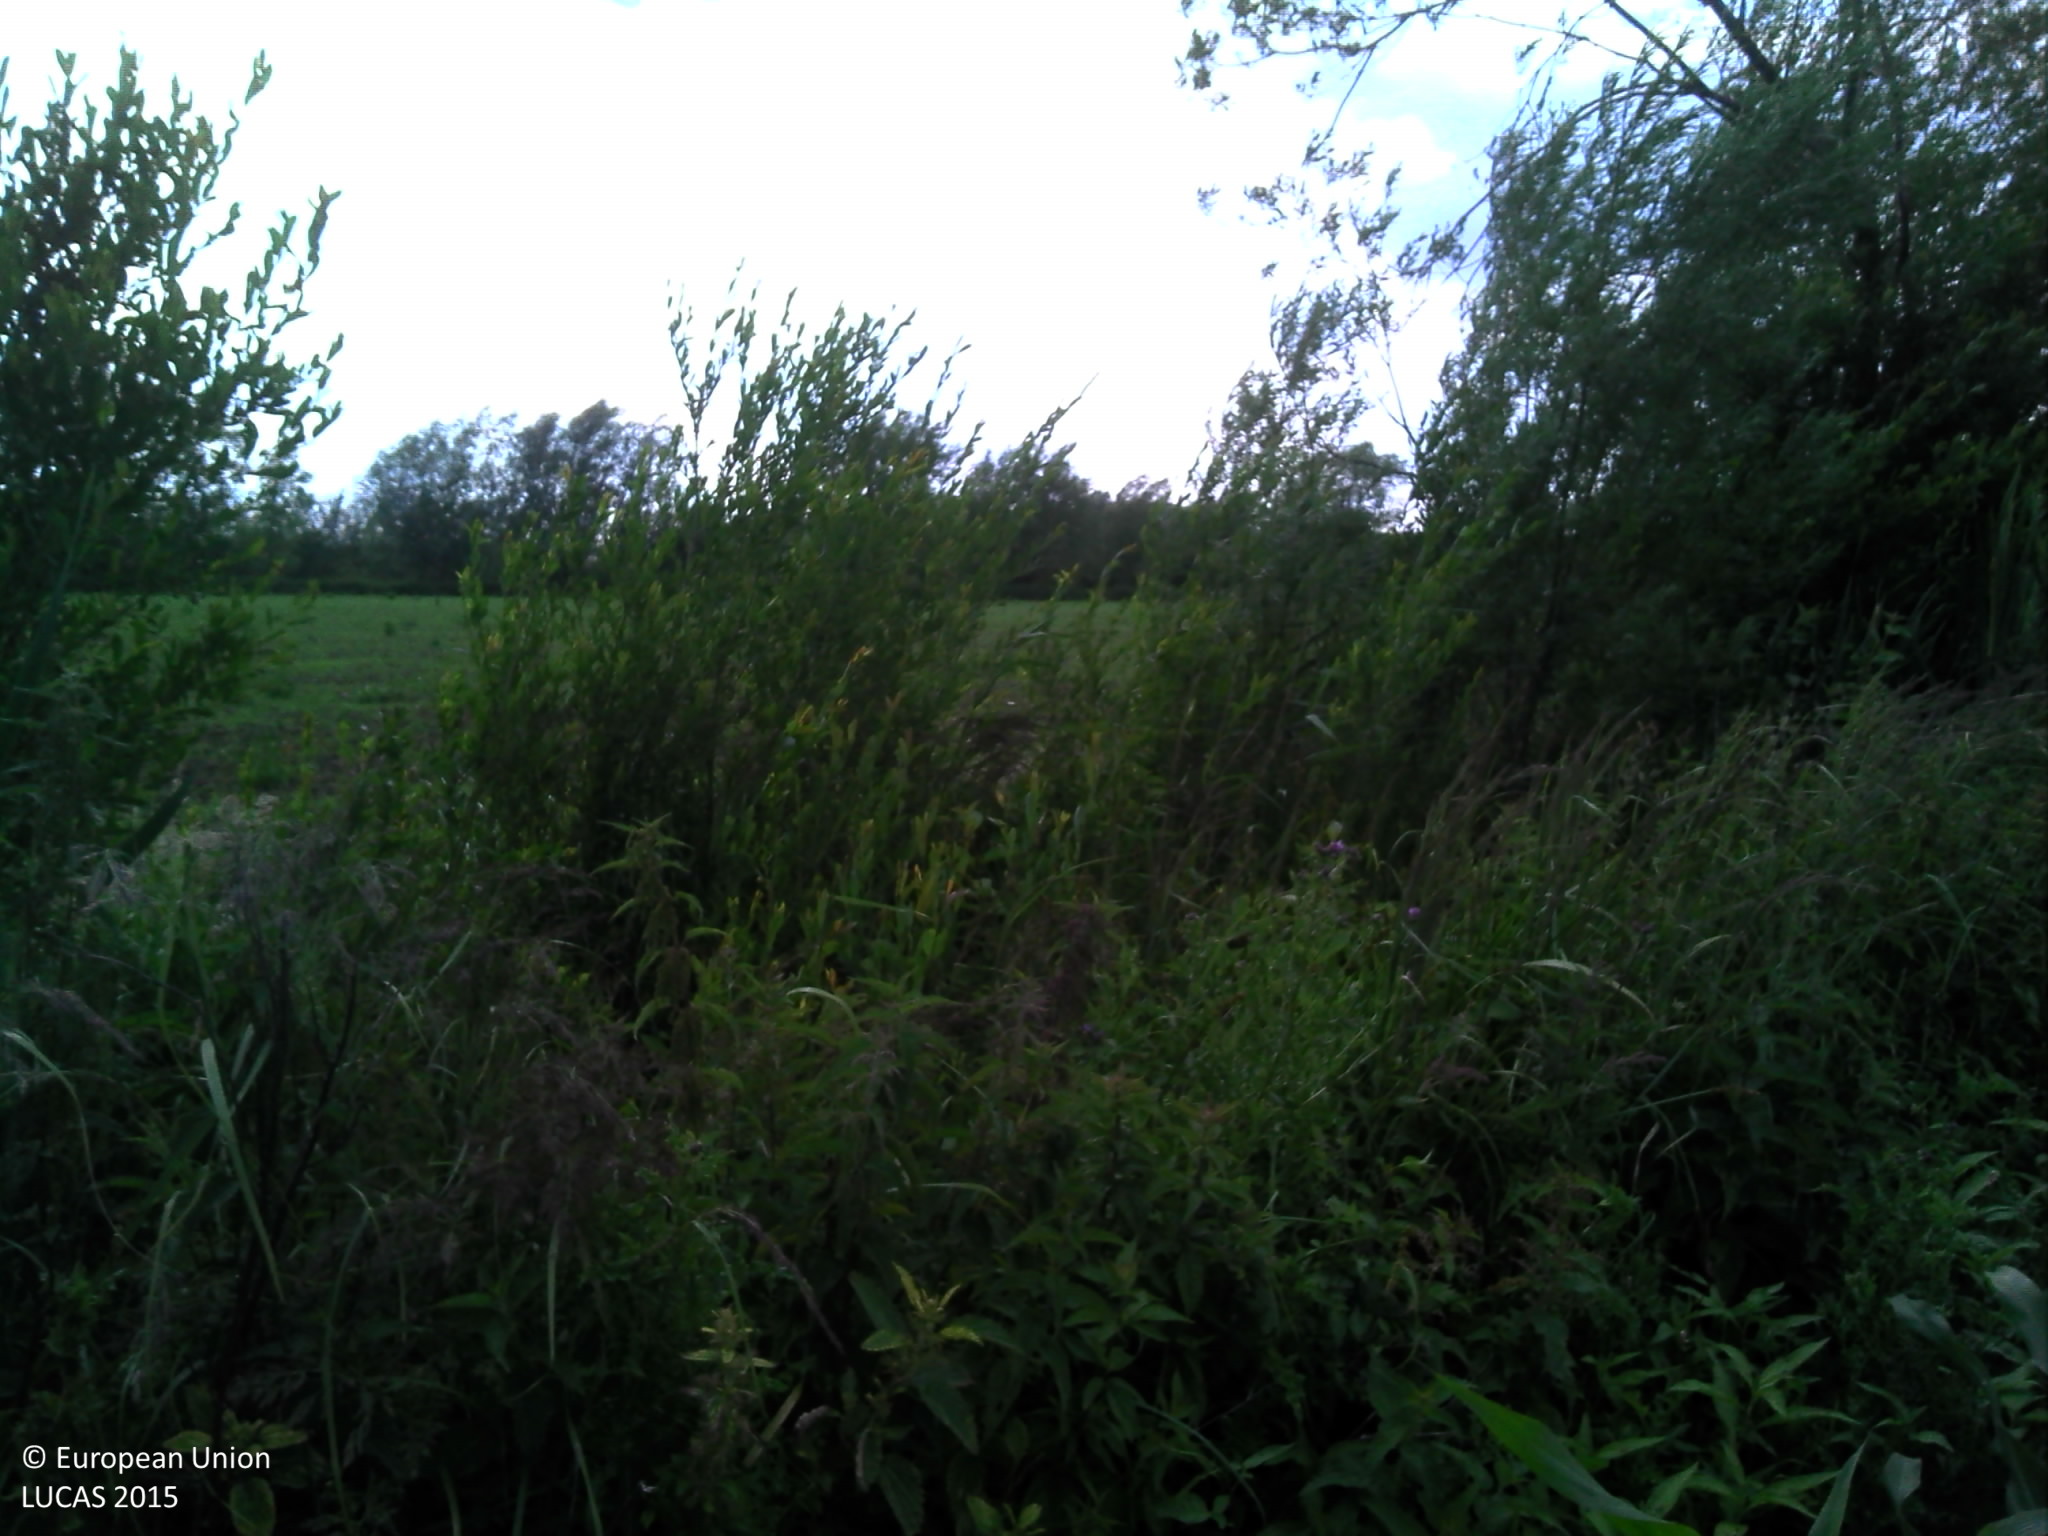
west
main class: Cropland
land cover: Maize
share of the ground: > 75 %
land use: Agriculture (excluding fallow land and kitchen gardens)
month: June
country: BE
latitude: 51.0981
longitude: 3.8102
